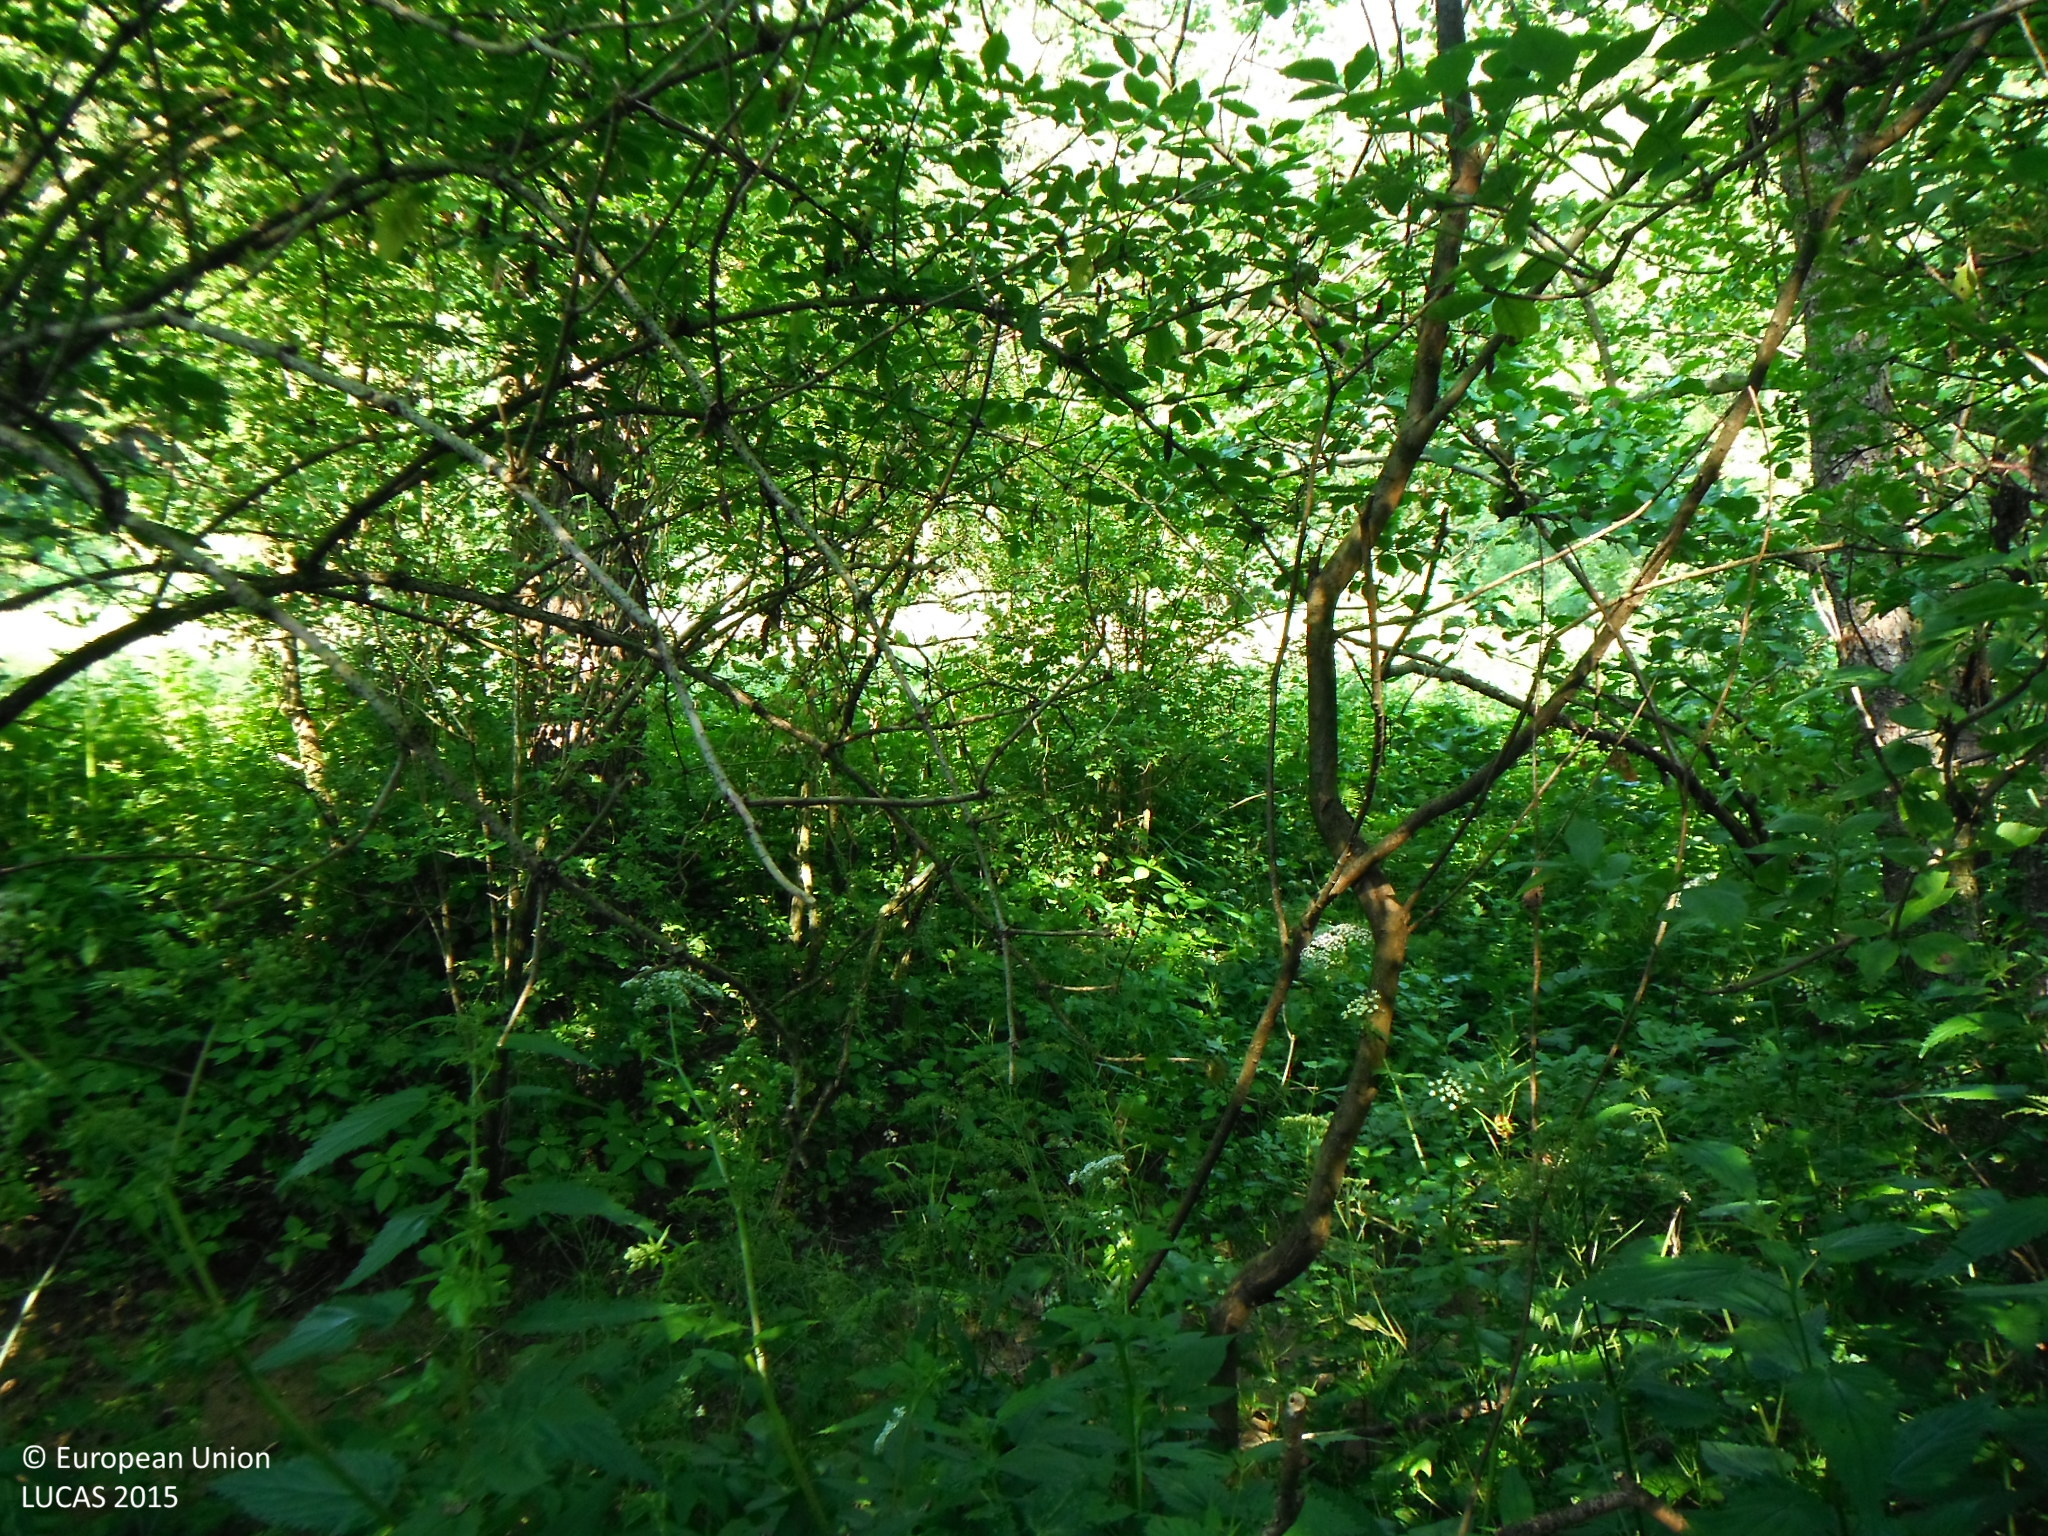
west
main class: Woodland
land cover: Broadleaved woodland
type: mesophytic deciduous forest
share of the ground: > 75 %
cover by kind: broadleaved forest trees 90 %, shrubs 10 %
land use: Semi-natural and natural areas not in use
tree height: > 5 m
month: July
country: SK
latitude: 48.9676
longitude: 21.8140
